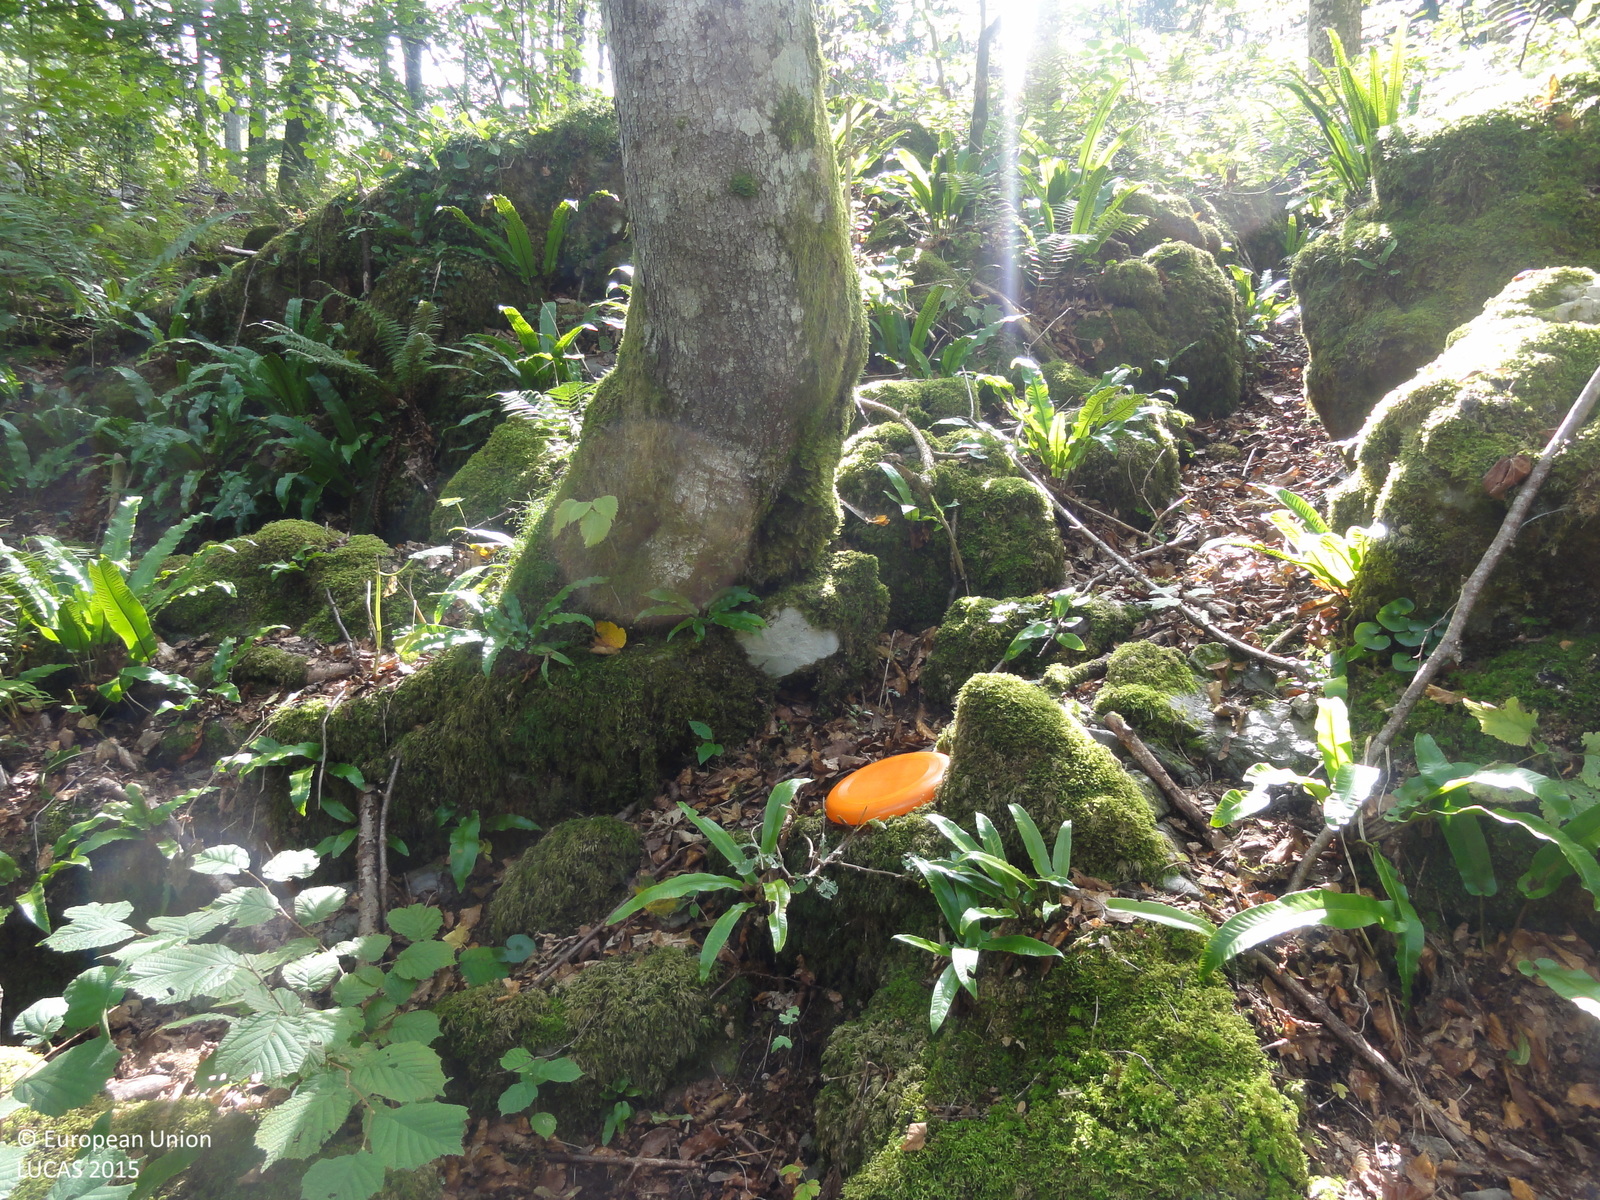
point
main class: Woodland
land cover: Broadleaved woodland
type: beech forest
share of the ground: > 75 %
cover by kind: broadleaved forest trees 90 %, coniferous forest trees 10 %
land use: Forestry
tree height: > 5 m
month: September
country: SI
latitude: 45.5806
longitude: 15.0838
